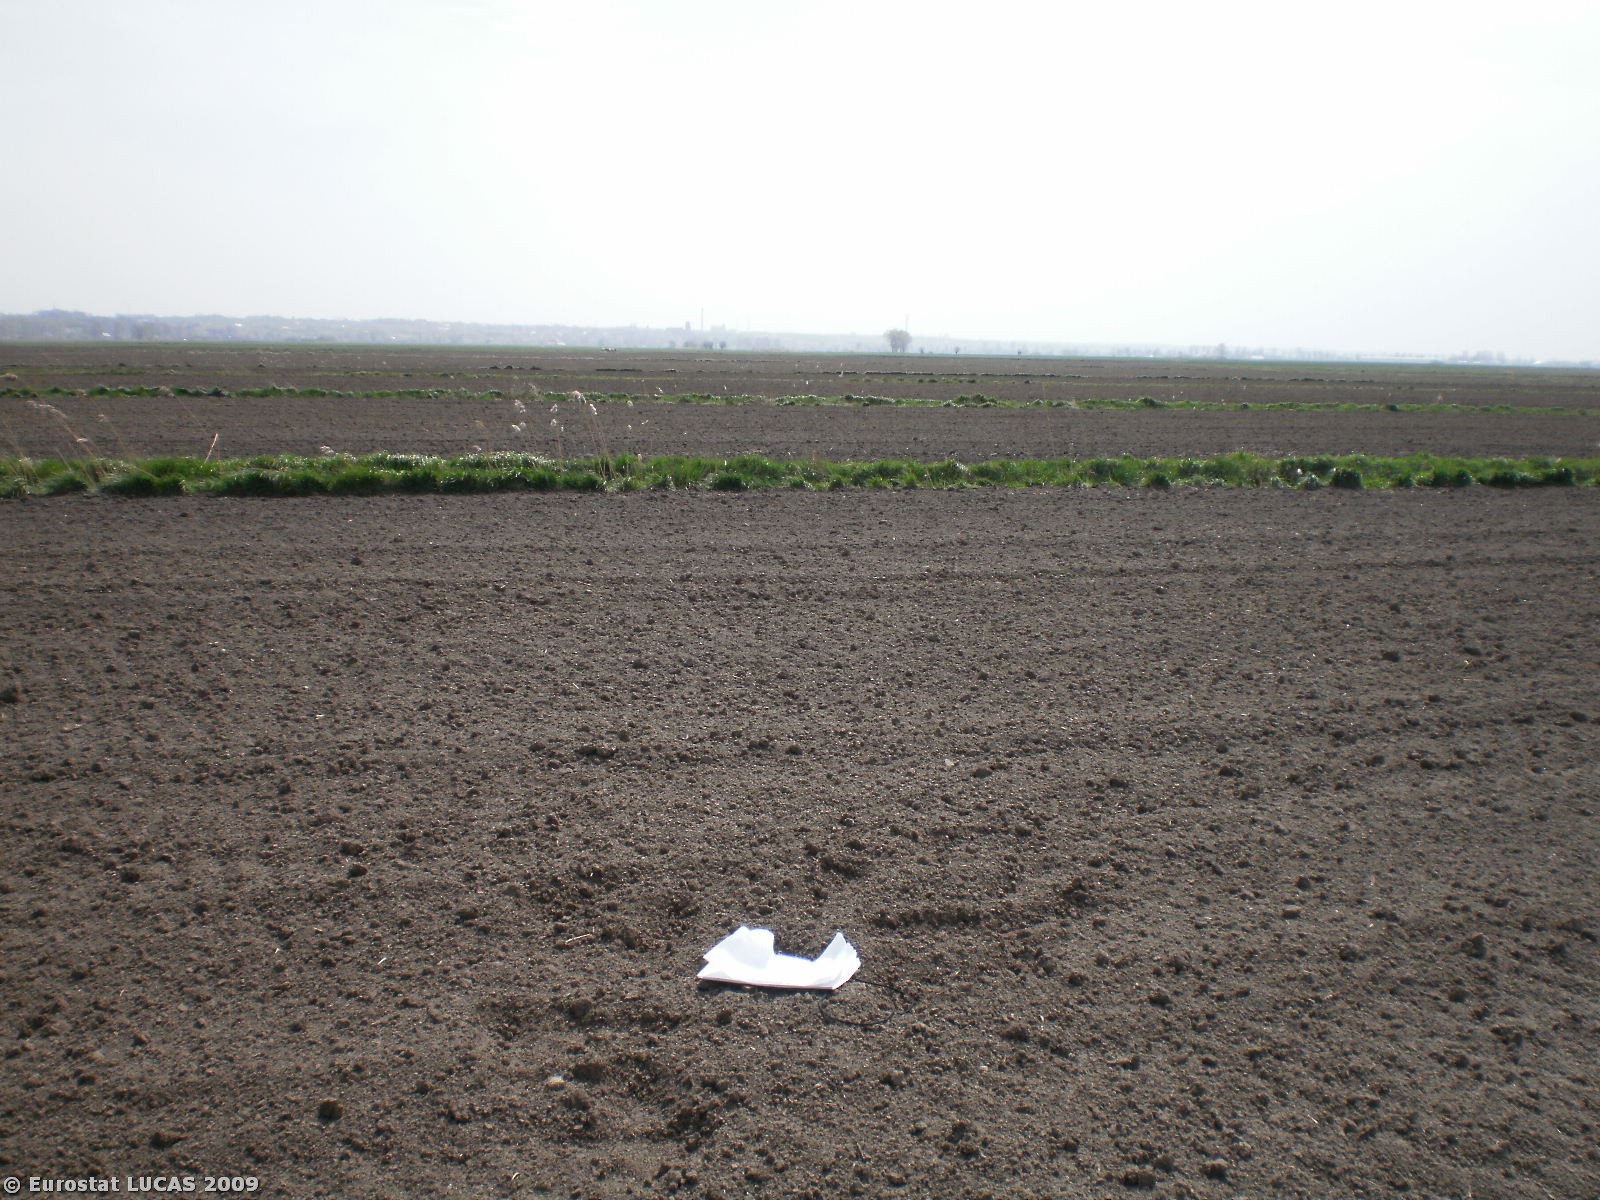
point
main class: Cropland
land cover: Common wheat
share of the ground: < 10 %
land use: Agriculture (excluding fallow land and kitchen gardens)
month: April
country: PL
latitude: 53.7794
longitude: 18.8987
